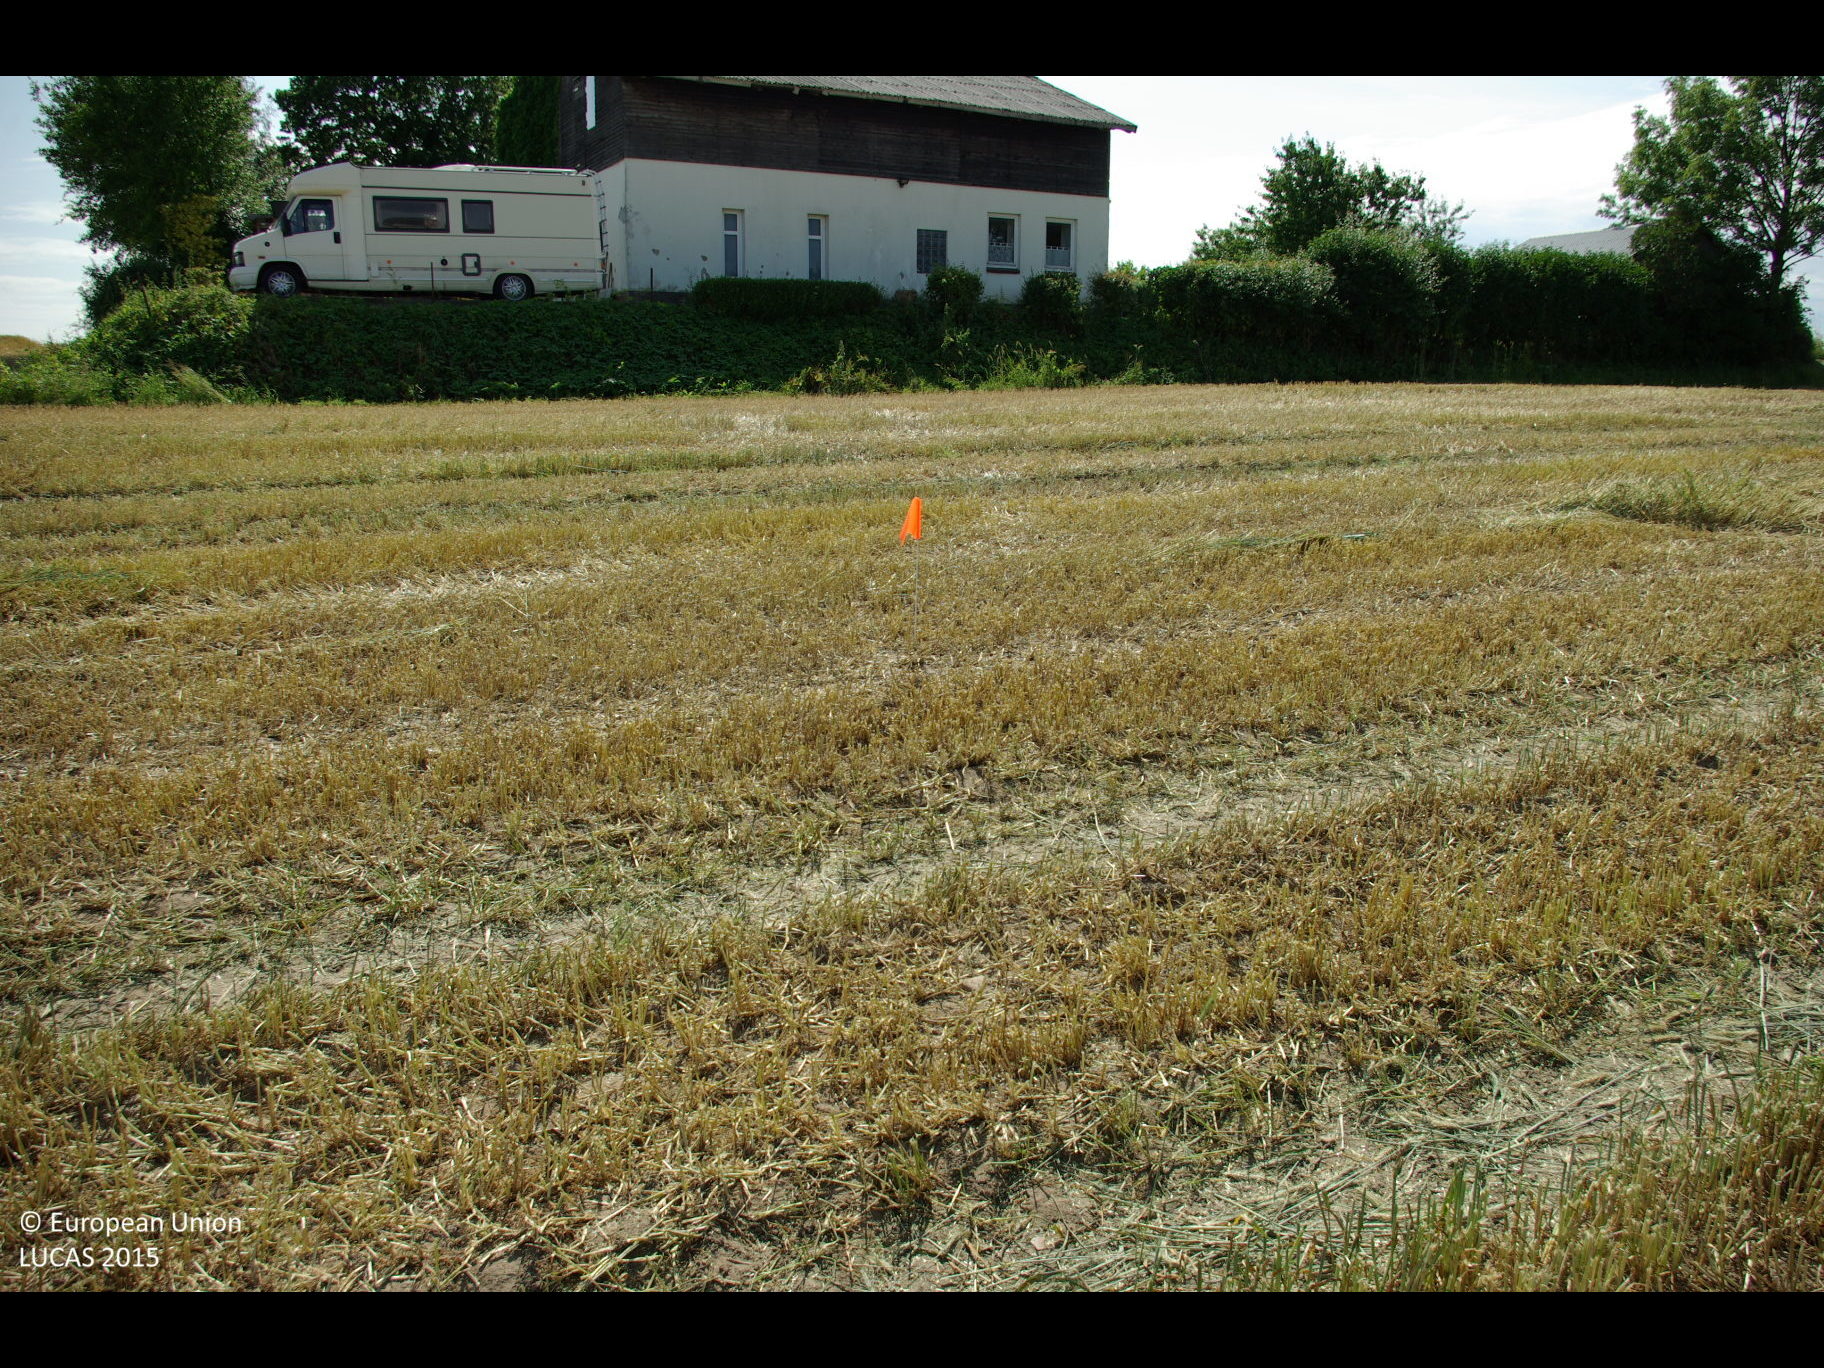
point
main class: Cropland
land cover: Rye
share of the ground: 10 - 25 %
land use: Agriculture (excluding fallow land and kitchen gardens)
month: July
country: DE
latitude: 54.6232
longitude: 9.5512
